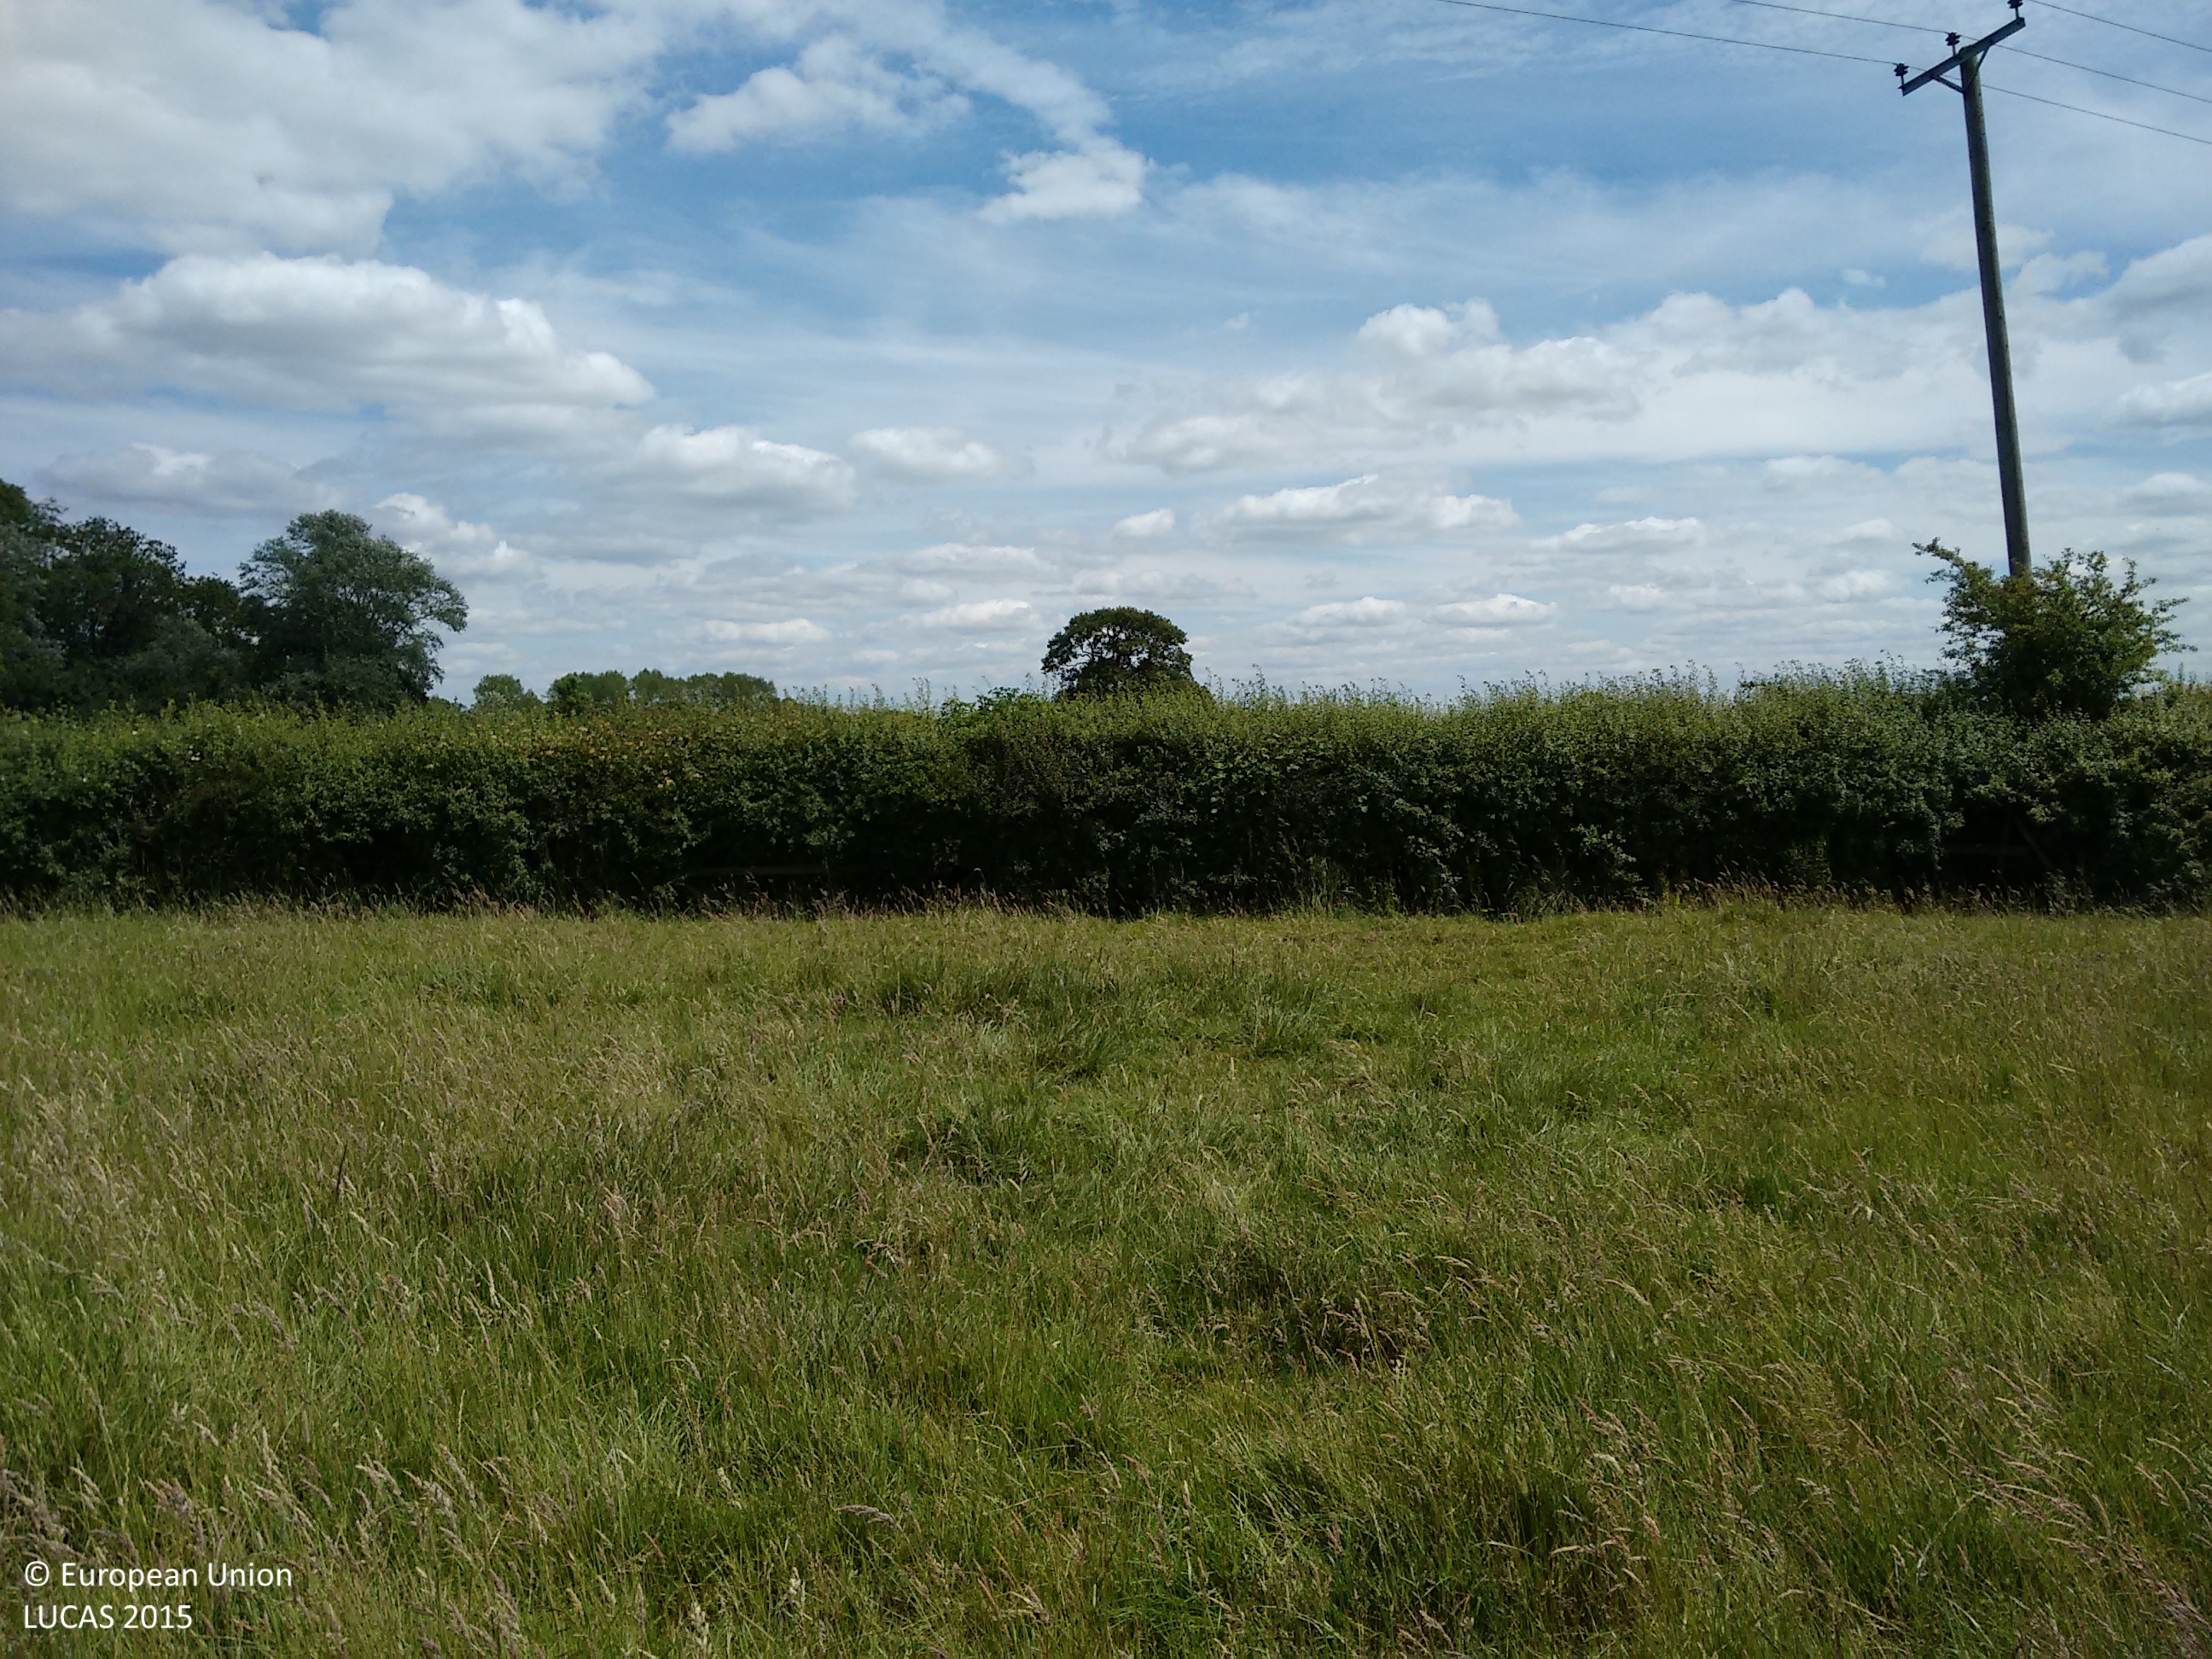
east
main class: Grassland
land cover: Grassland without tree/shrub cover
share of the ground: > 75 %
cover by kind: herbaceous plants 100 %
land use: Agriculture (excluding fallow land and kitchen gardens)
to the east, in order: Grassland without tree/shrub cover; Electric lines; Fences; Managed hedges; Grassland without tree/shrub cover; Fences; Managed hedges; Grassland without tree/shrub cover; Grassland with sparse tree/shrub cover; Grassland without tree/shrub cover; Maize
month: June
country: GB
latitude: 51.6254
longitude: -1.5943
